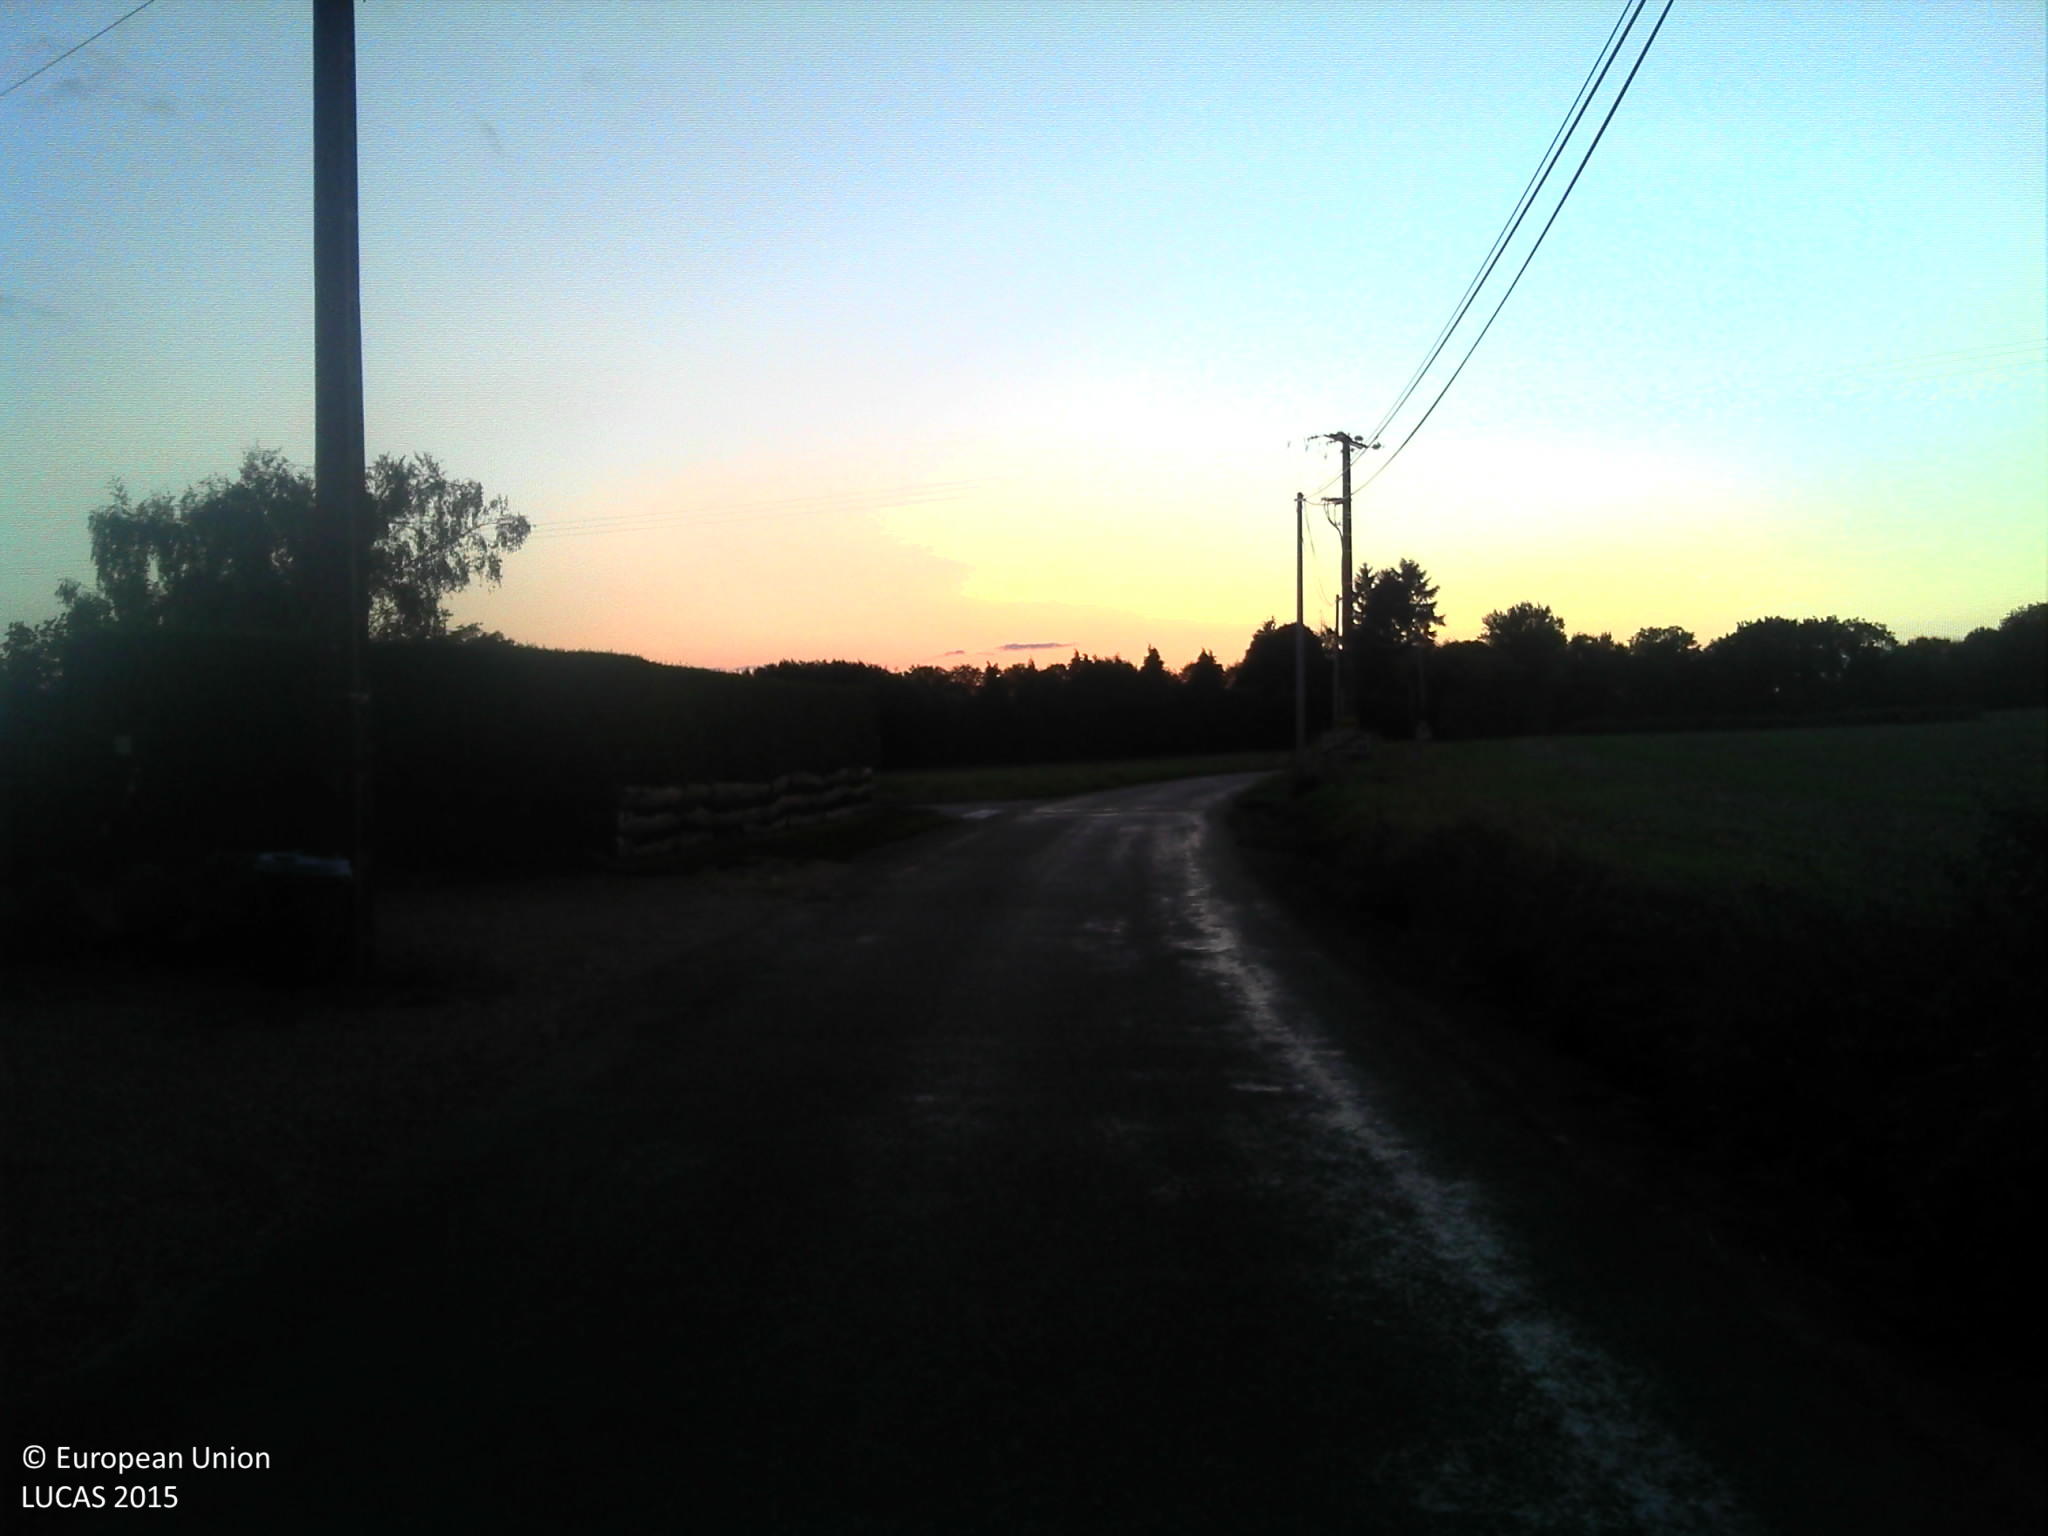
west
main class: Grassland
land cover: Grassland with sparse tree/shrub cover
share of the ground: > 75 %
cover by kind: herbaceous plants 95 %, broadleaved forest trees 5 %
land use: Residential
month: September
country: FR
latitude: 48.3751
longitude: 0.5117
